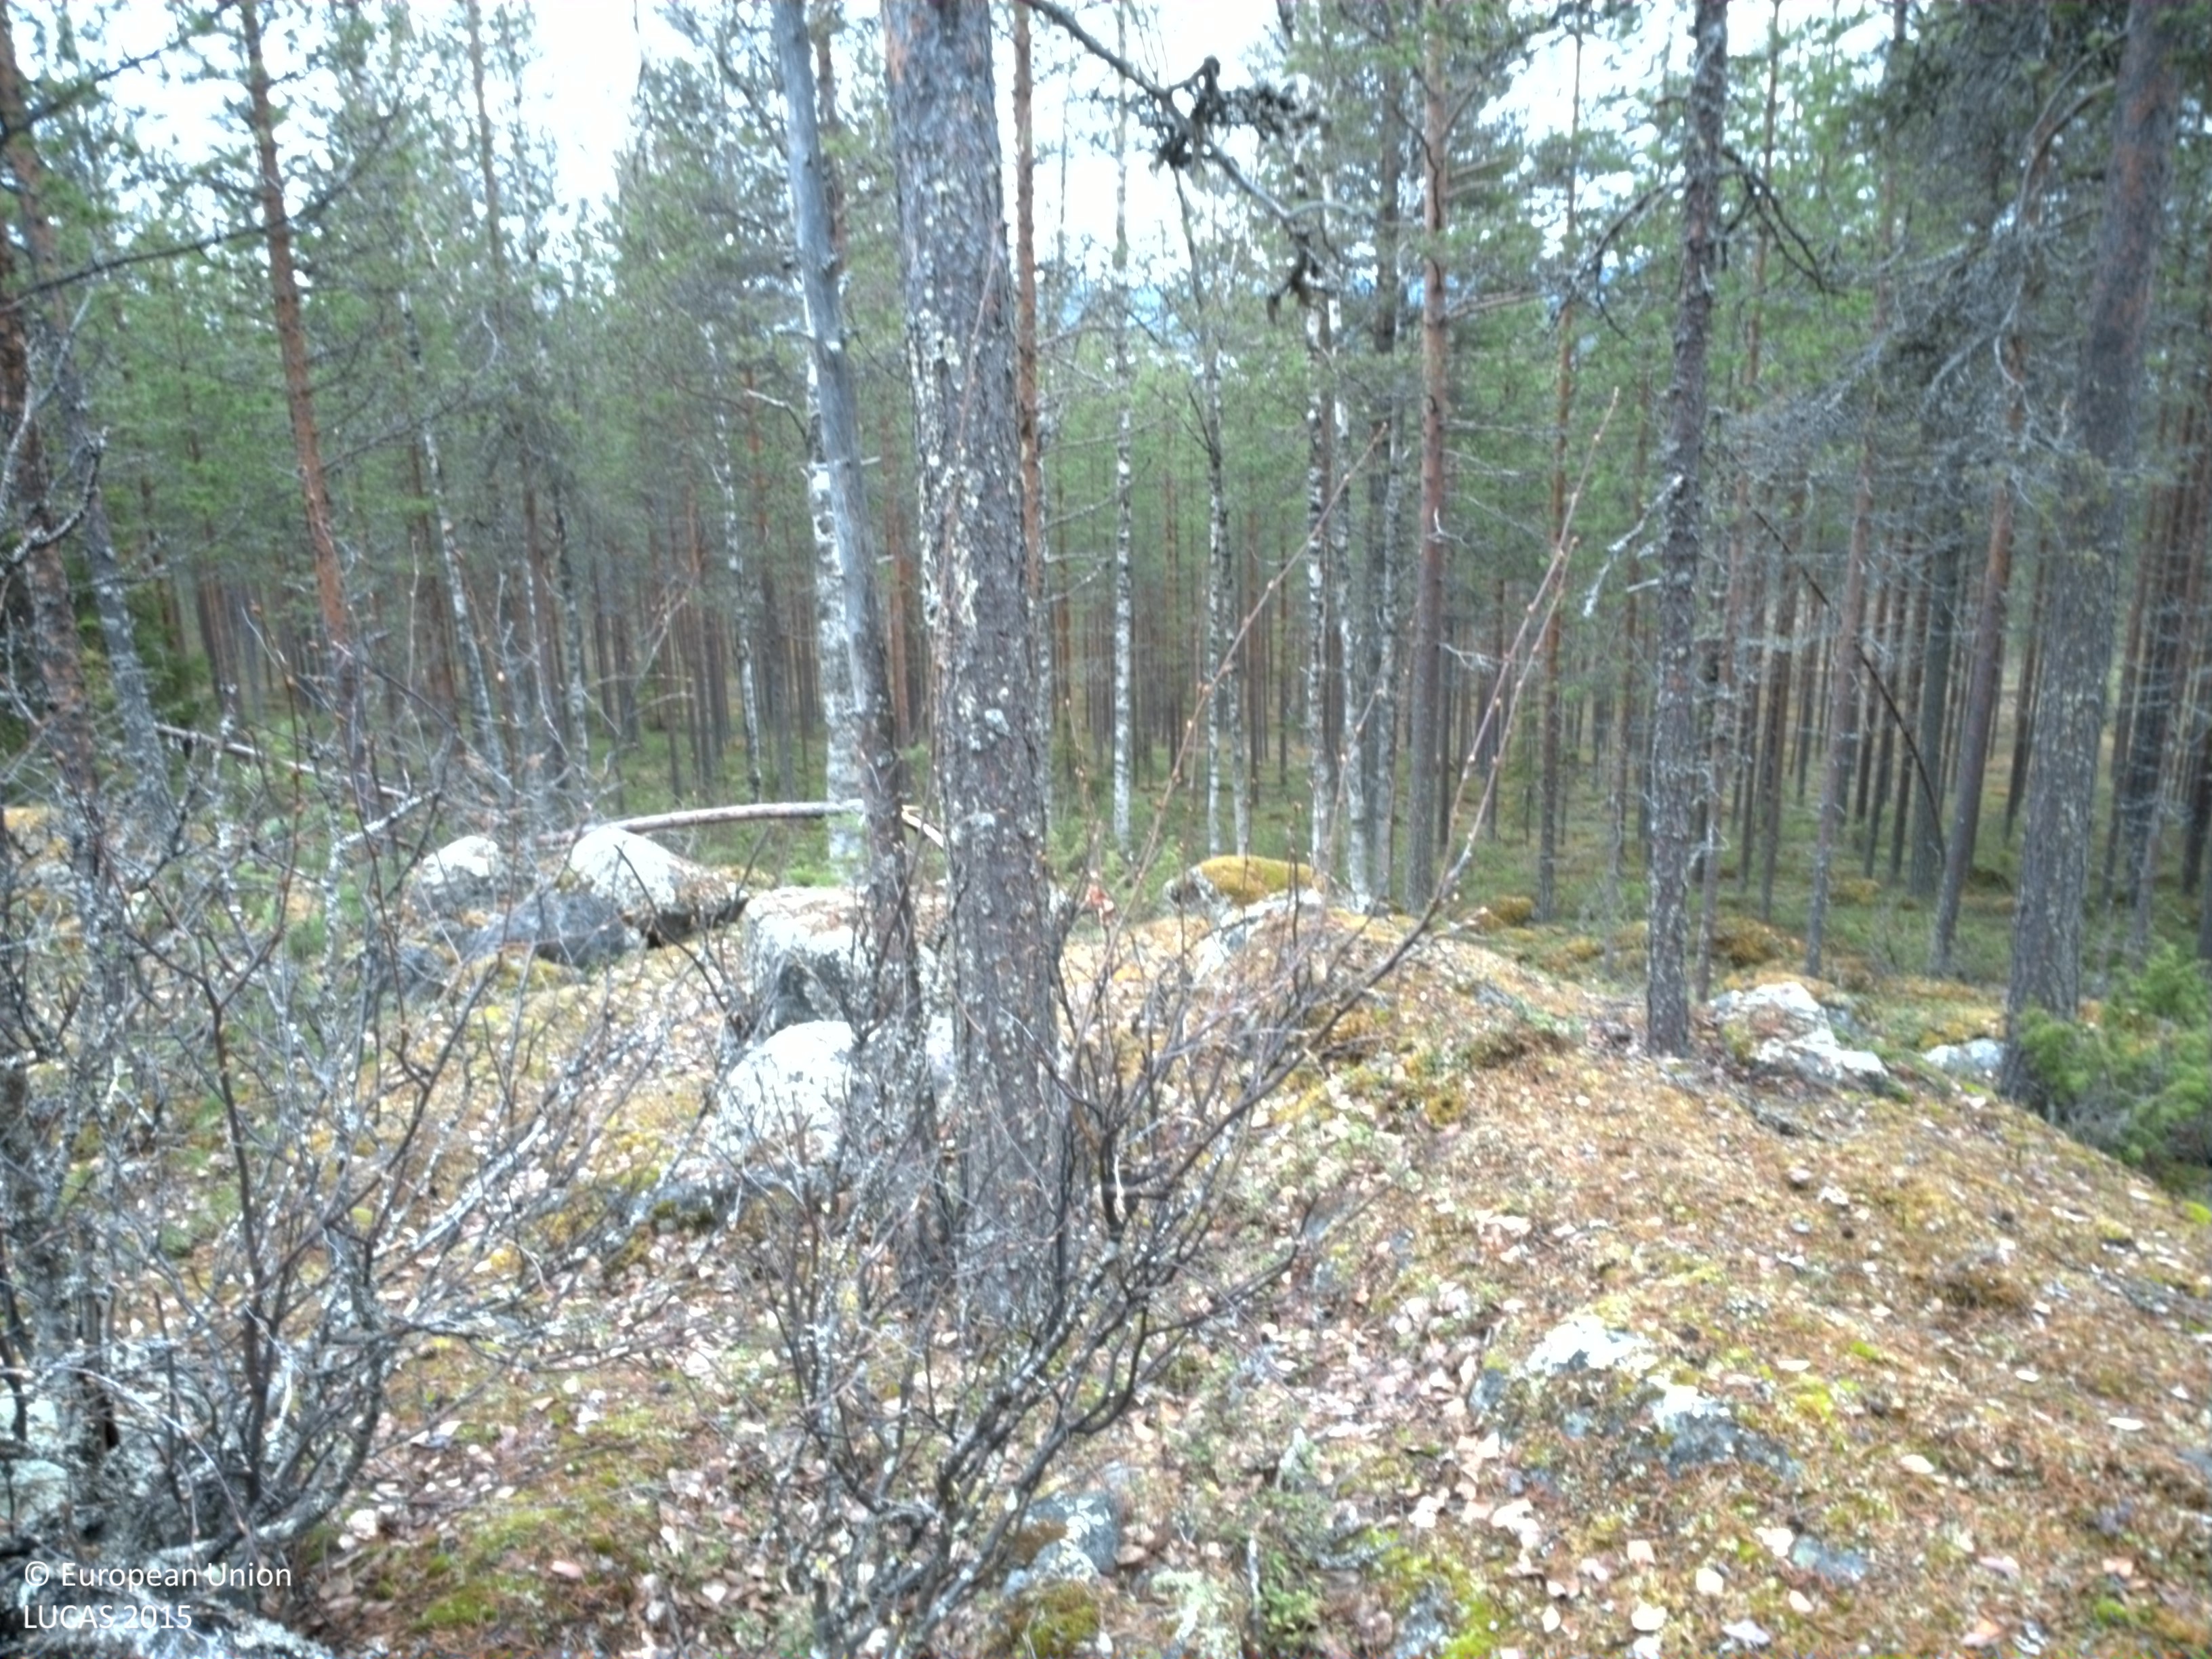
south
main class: Woodland
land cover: Pine dominated coniferous woodland
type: boreal forest
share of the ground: 50 - 75 %
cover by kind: coniferous forest trees 65 %, lichens and mosses 25 %, shrubs 10 %
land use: Forestry
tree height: > 5 m
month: May
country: SE
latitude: 66.4949
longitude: 23.6248
